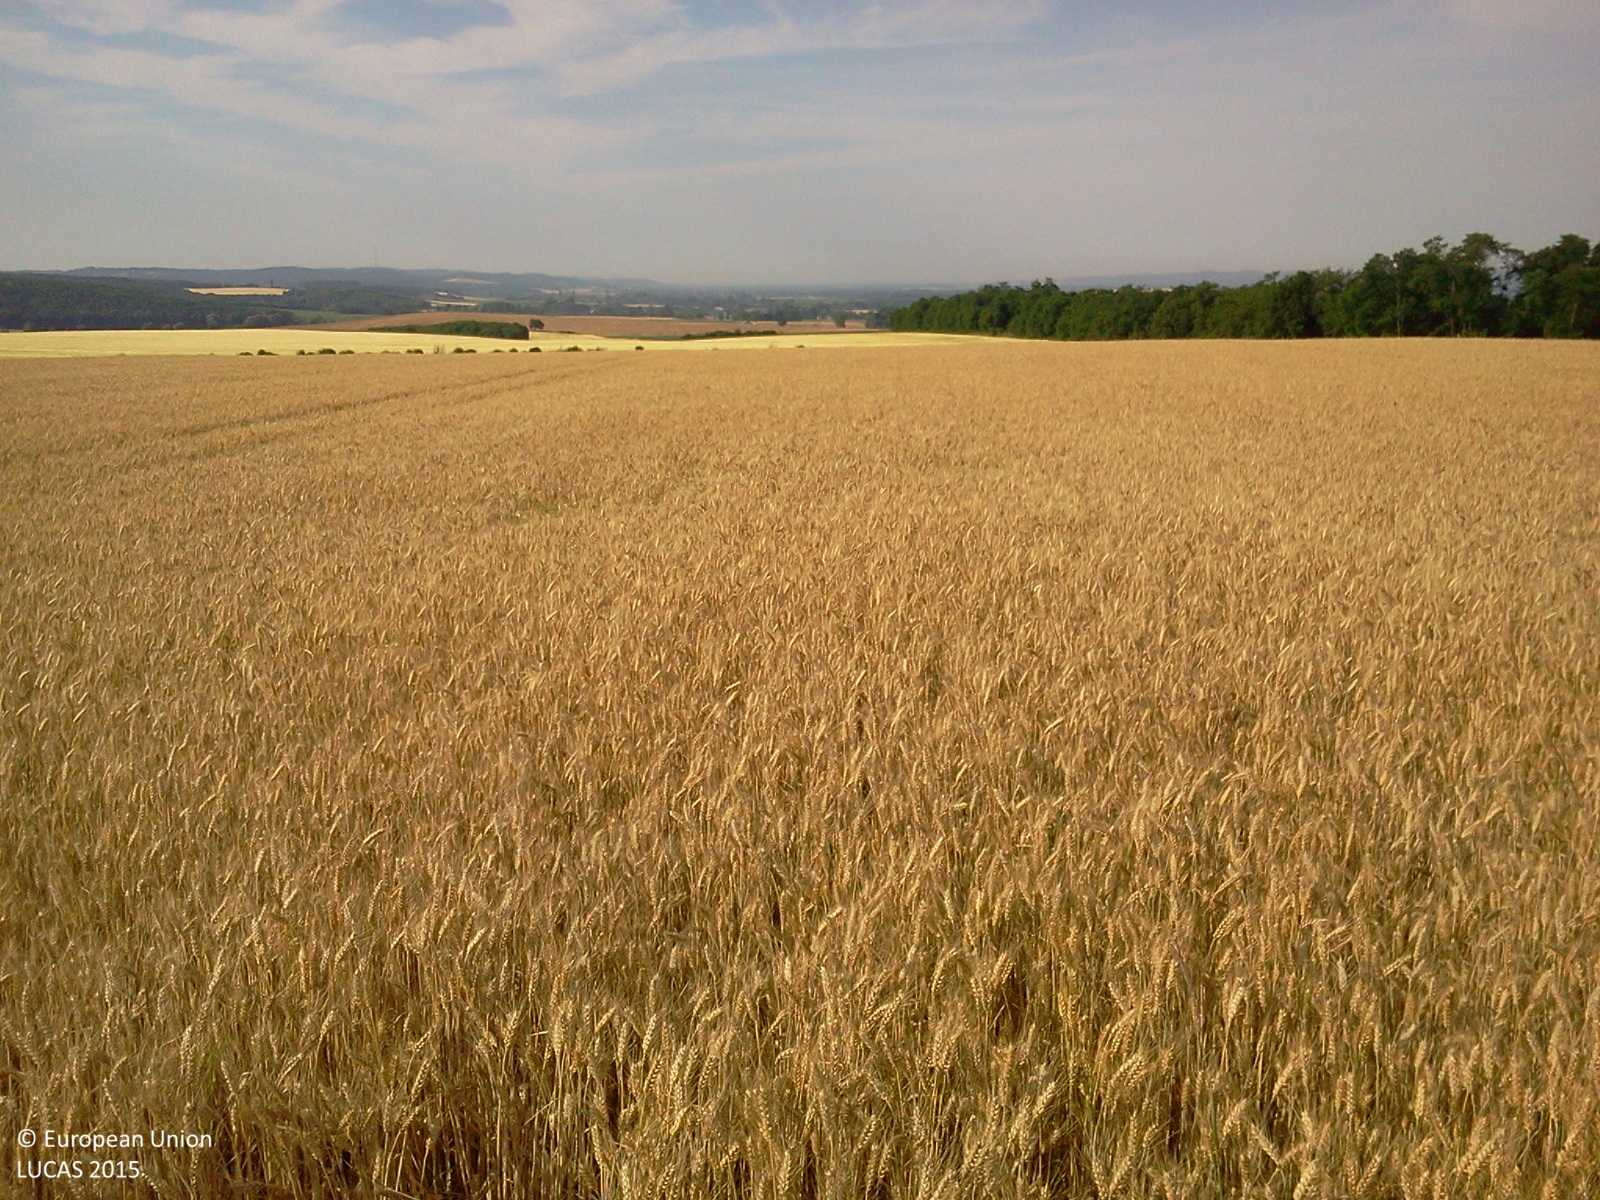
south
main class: Cropland
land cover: Common wheat
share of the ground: > 75 %
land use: Agriculture (excluding fallow land and kitchen gardens)
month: June
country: HU
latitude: 46.6822
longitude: 16.9980
